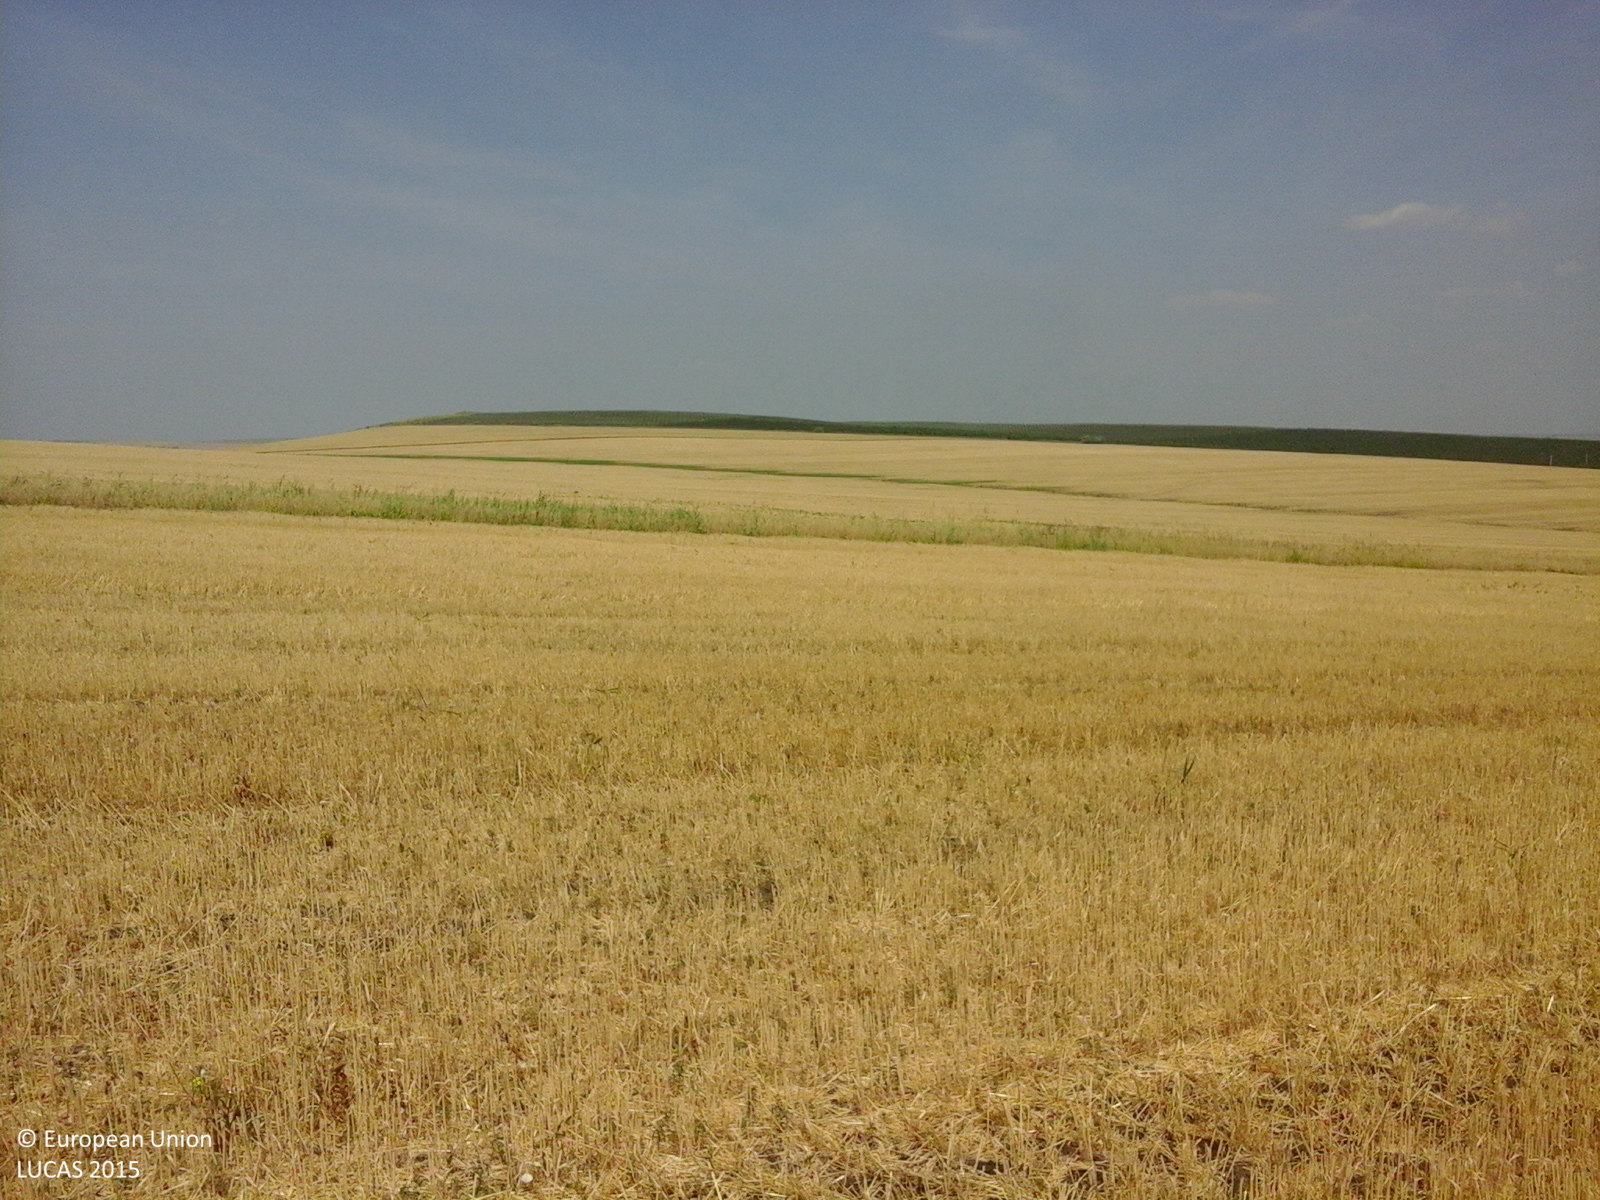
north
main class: Cropland
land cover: Common wheat
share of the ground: > 75 %
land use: Agriculture (excluding fallow land and kitchen gardens)
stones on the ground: < 10 %
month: July
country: RO
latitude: 46.6270
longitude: 28.1428
